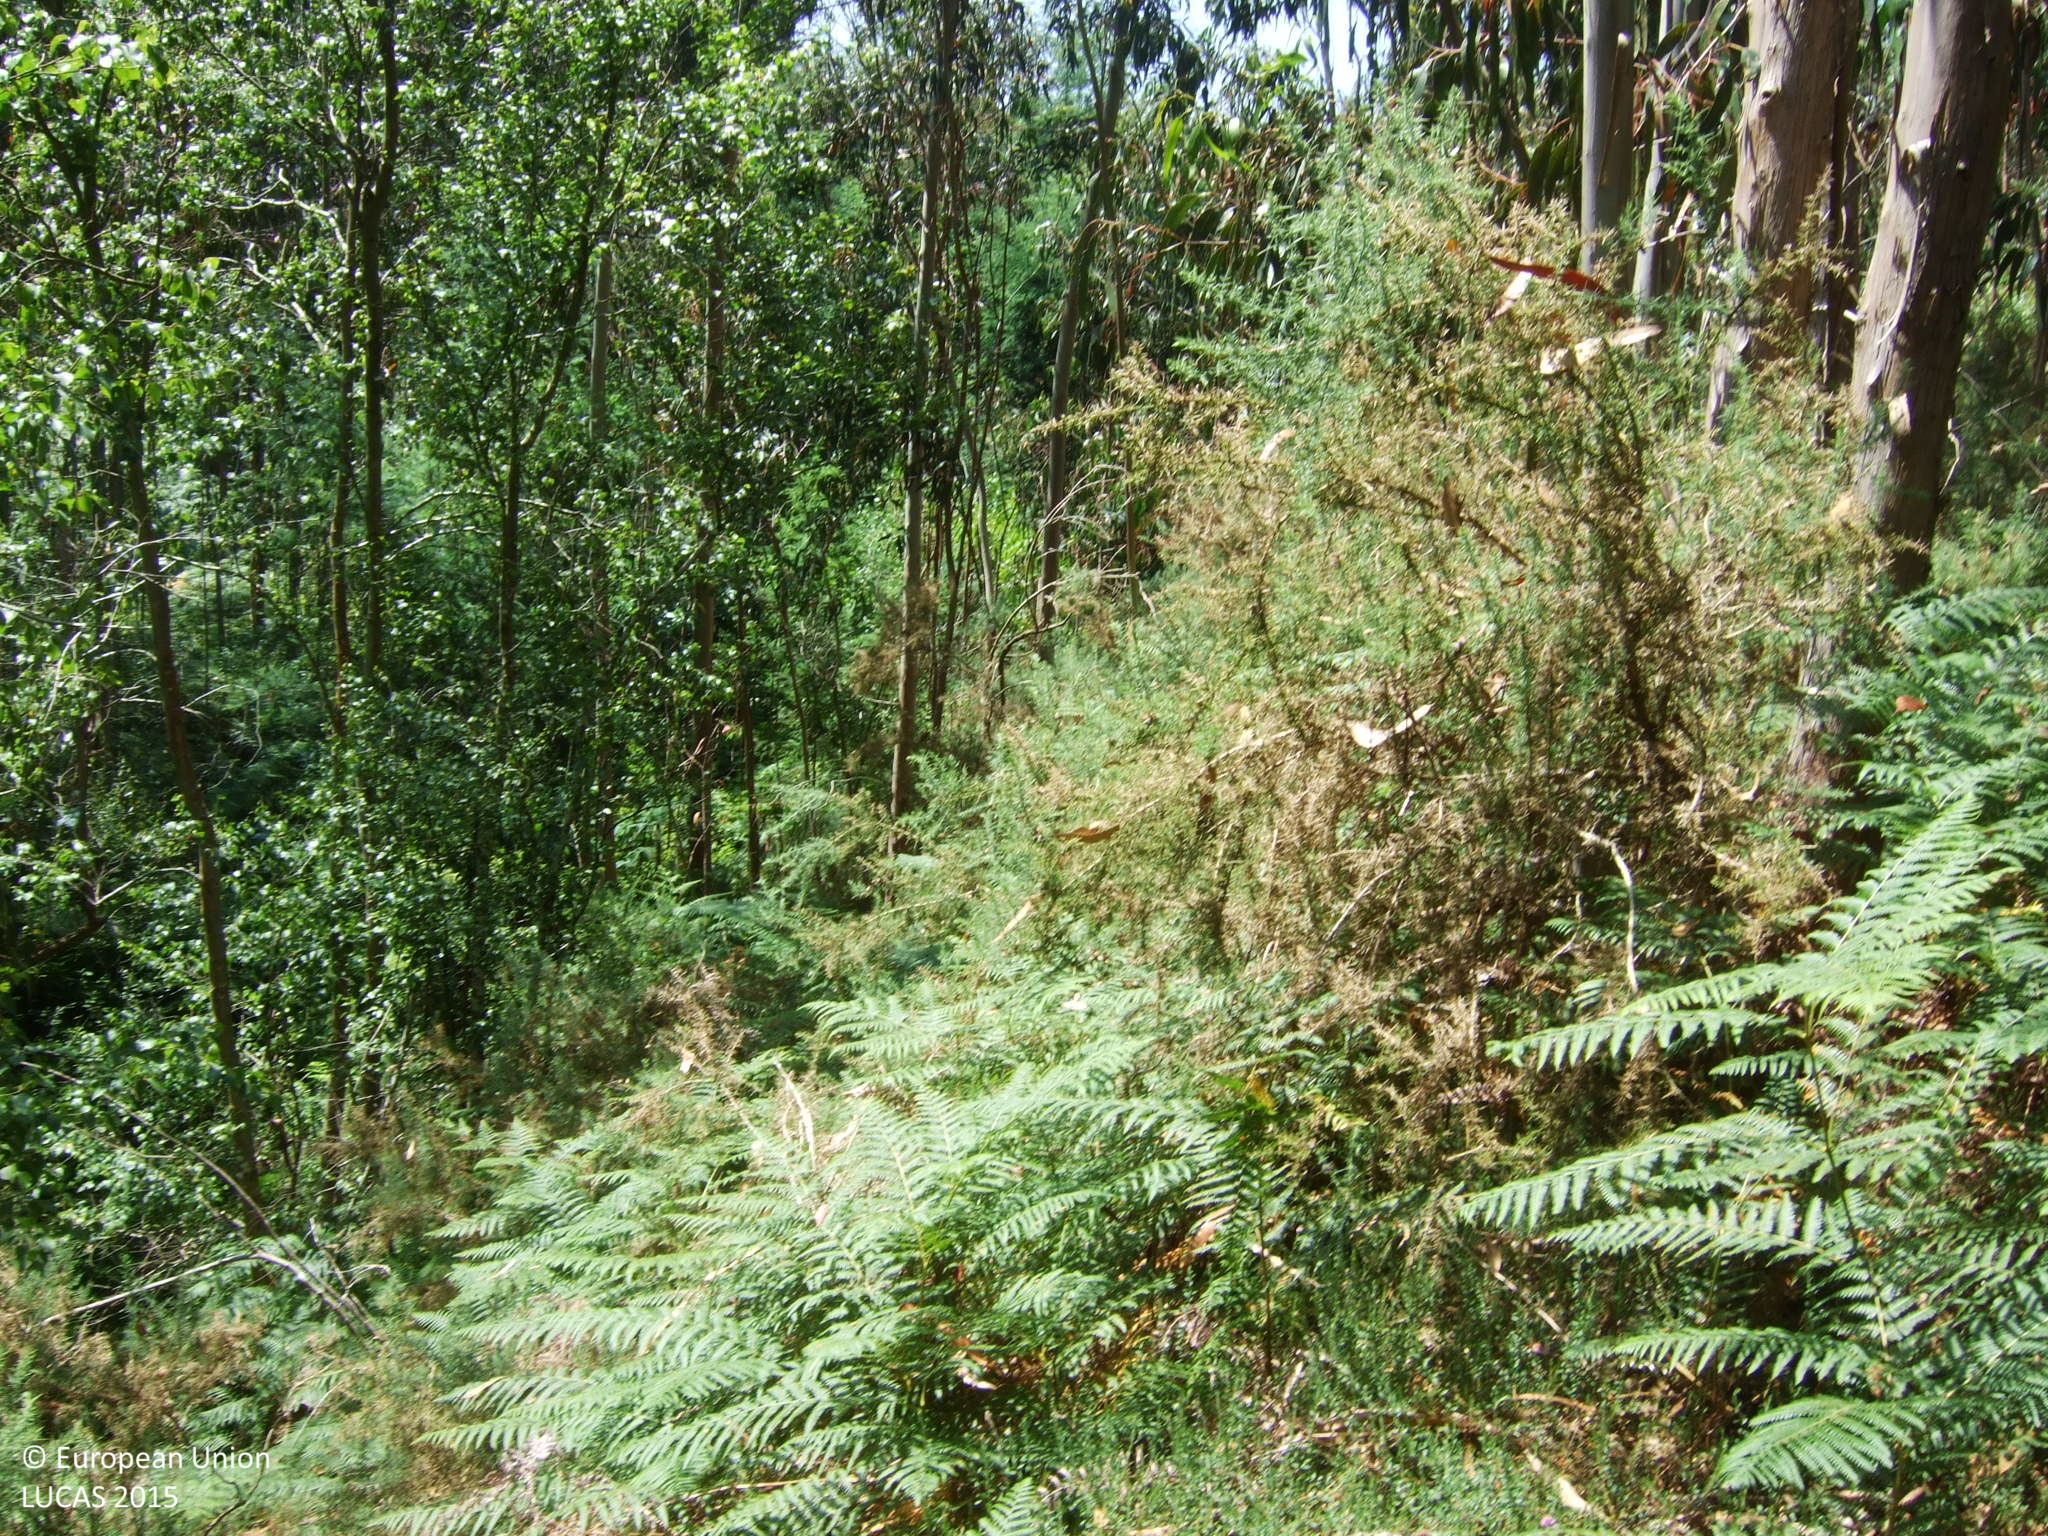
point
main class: Woodland
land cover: Broadleaved woodland
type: exotic forest
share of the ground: 25 - 50 %
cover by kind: shrubs 65 %, broadleaved forest trees 35 %
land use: Forestry
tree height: > 5 m
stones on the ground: < 10 %
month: June
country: ES
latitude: 43.6314
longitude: -7.3441
